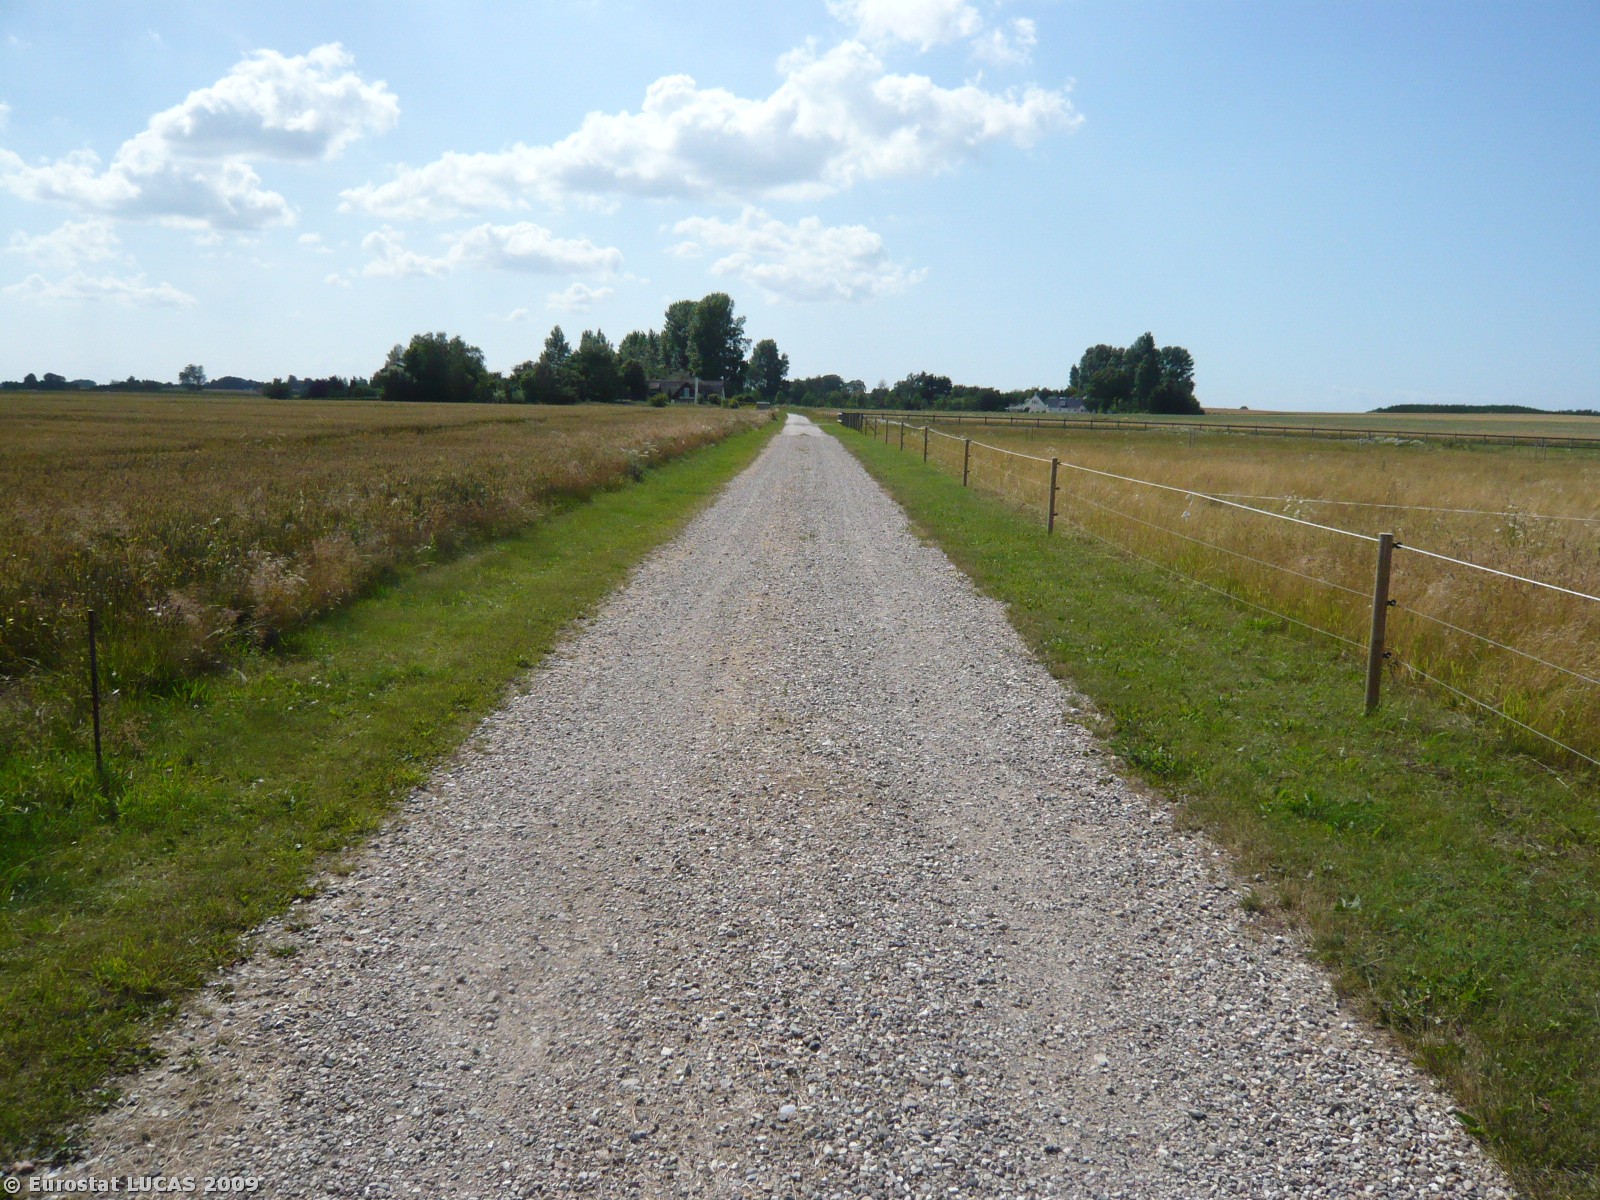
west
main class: Grassland
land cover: Grassland without tree/shrub cover
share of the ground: > 75 %
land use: Agriculture (excluding fallow land and kitchen gardens)
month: July
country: DK
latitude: 55.7625
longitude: 11.7355
